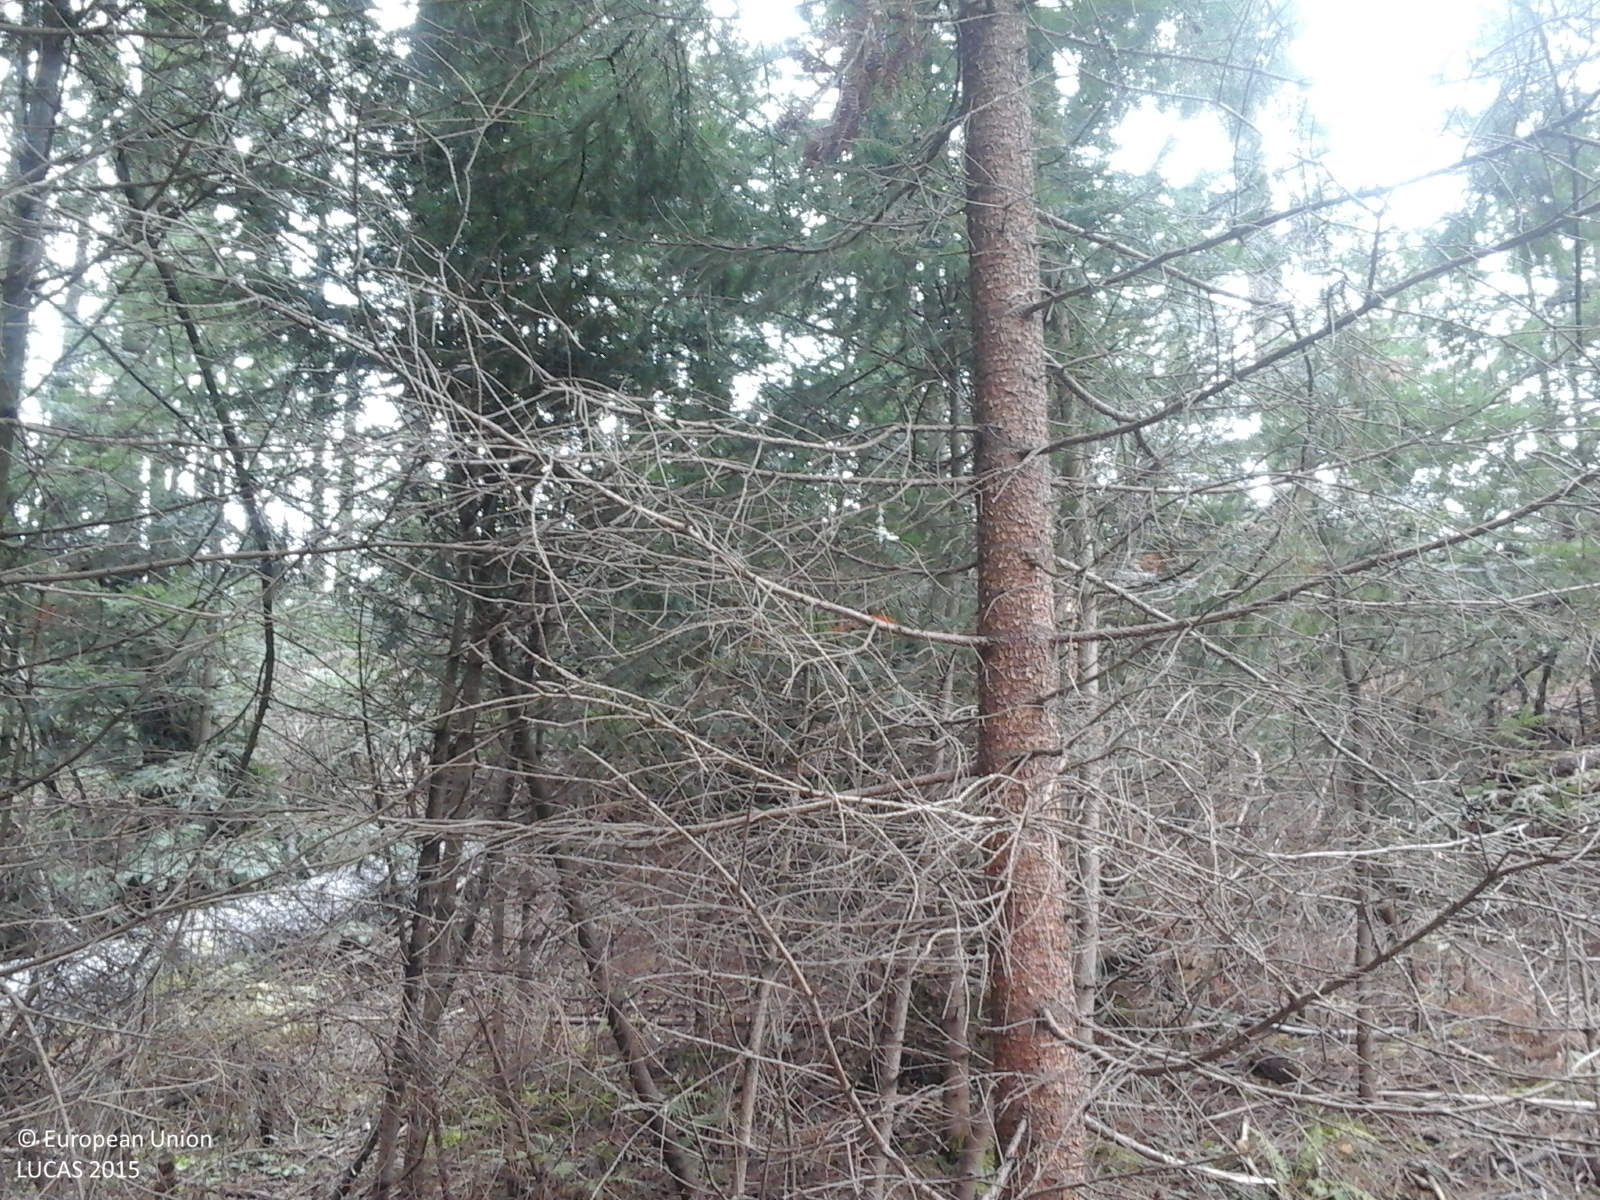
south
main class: Woodland
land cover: Spruce dominated coniferous woodland
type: alpine coniferous forest
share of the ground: > 75 %
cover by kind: coniferous forest trees 100 %
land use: Forestry
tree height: > 5 m
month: October
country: RO
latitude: 46.6190
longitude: 25.5329
